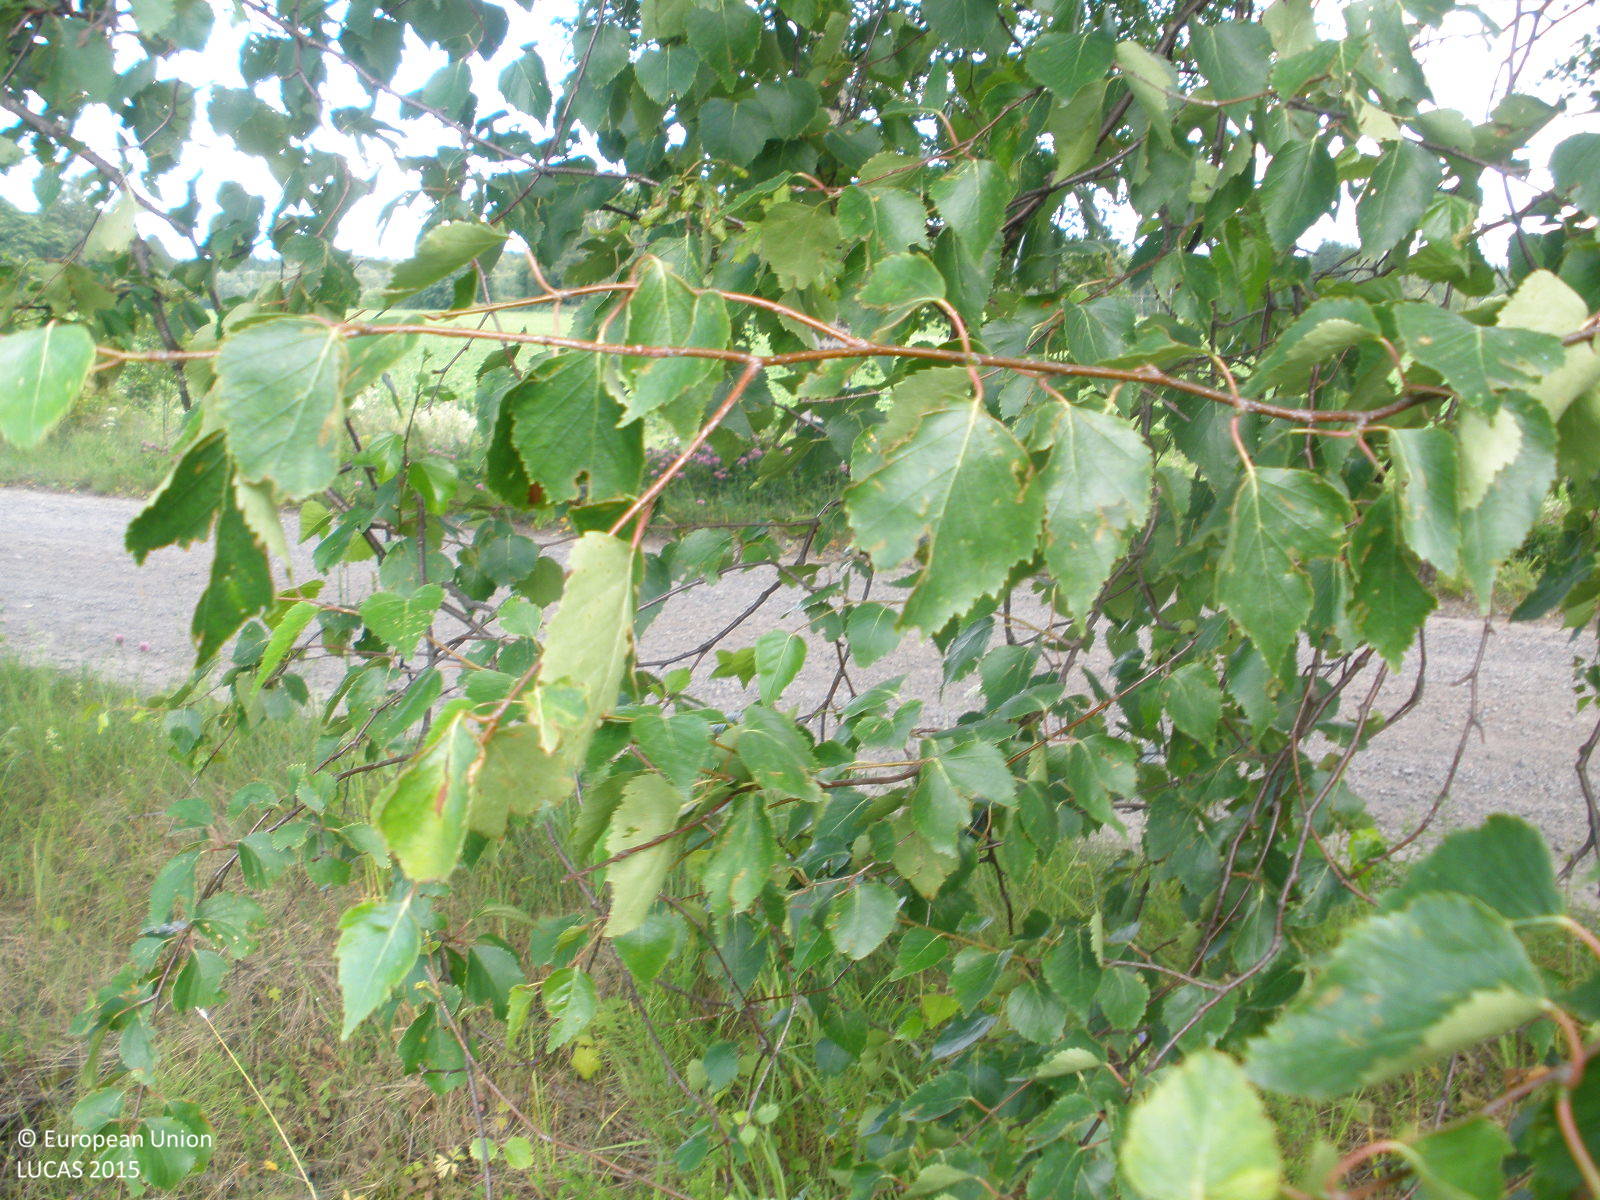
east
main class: Cropland
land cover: Rape and turnip rape
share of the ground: > 75 %
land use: Agriculture (excluding fallow land and kitchen gardens)
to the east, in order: Rape and turnip rape; Lines of trees; Tracks; Lines of trees; Spontaneously vegetated surfaces; Potatoes
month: July
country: FI
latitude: 61.0992
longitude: 25.0075
